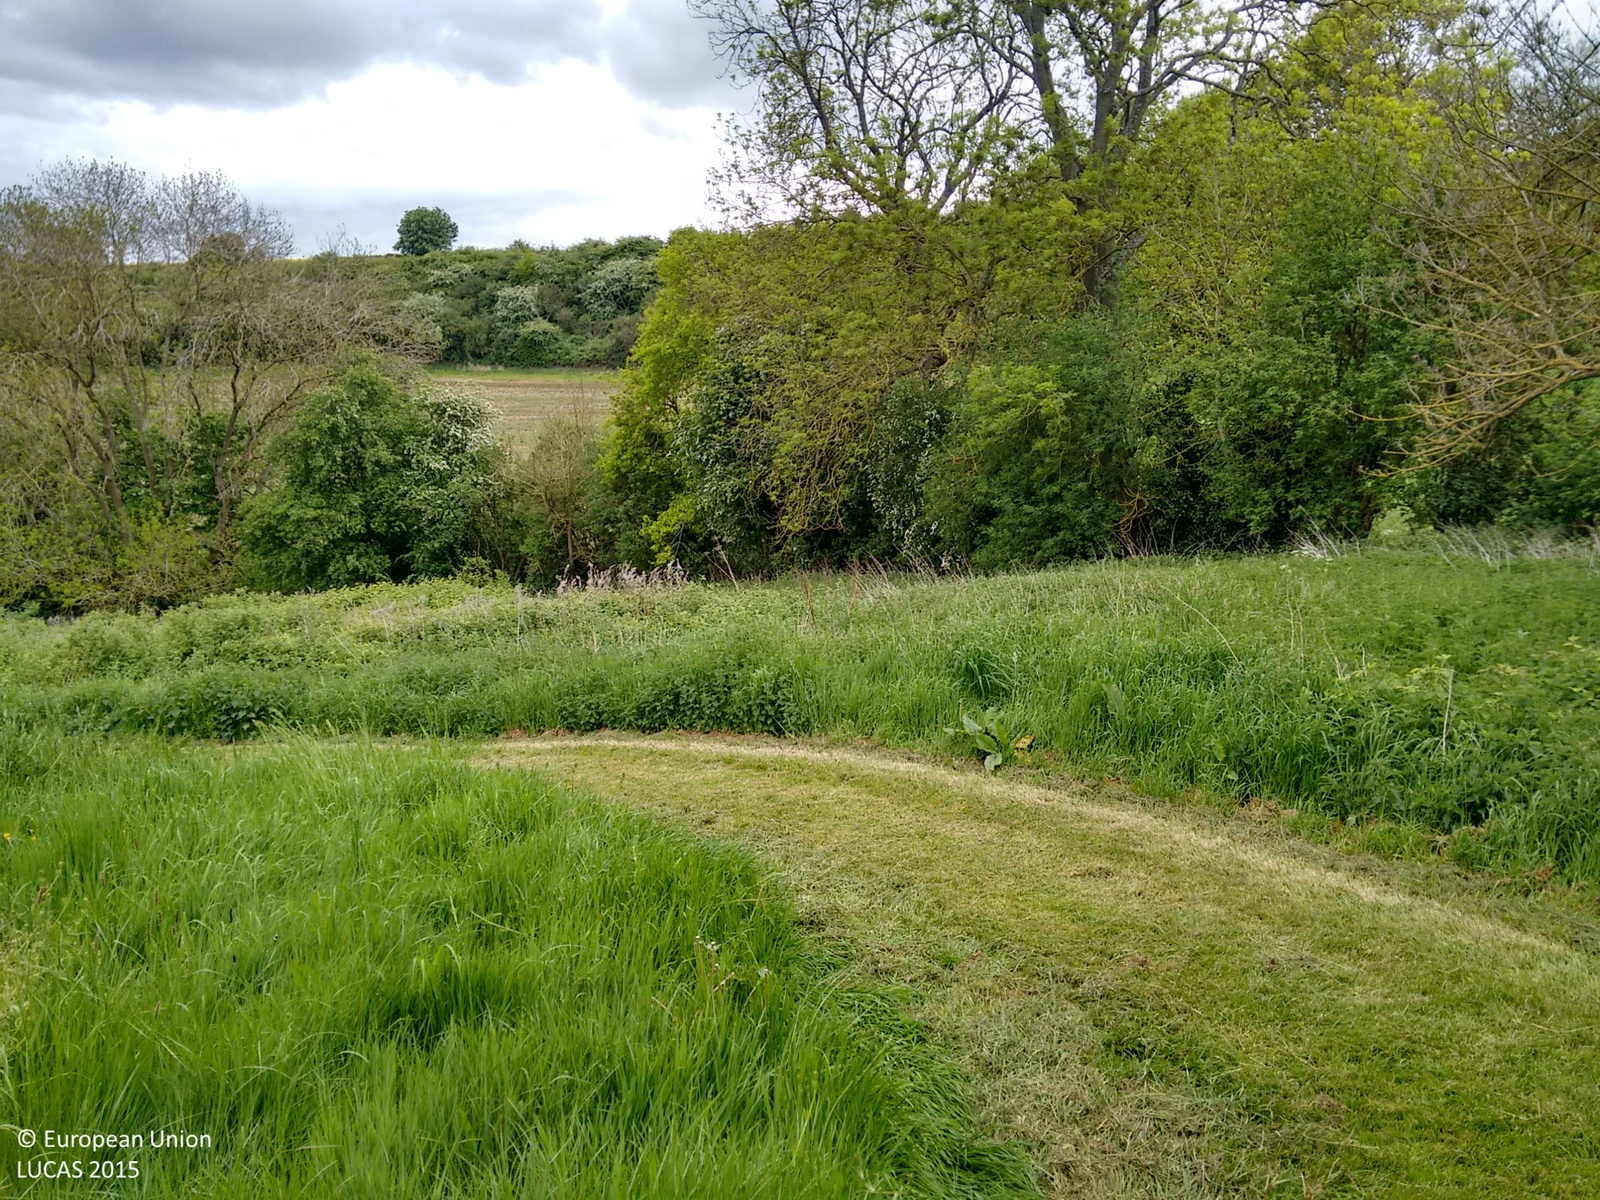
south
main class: Grassland
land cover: Grassland without tree/shrub cover
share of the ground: > 75 %
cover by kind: herbaceous plants 100 %
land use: Agriculture (excluding fallow land and kitchen gardens)
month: May
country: GB
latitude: 52.1171
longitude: -1.3970
